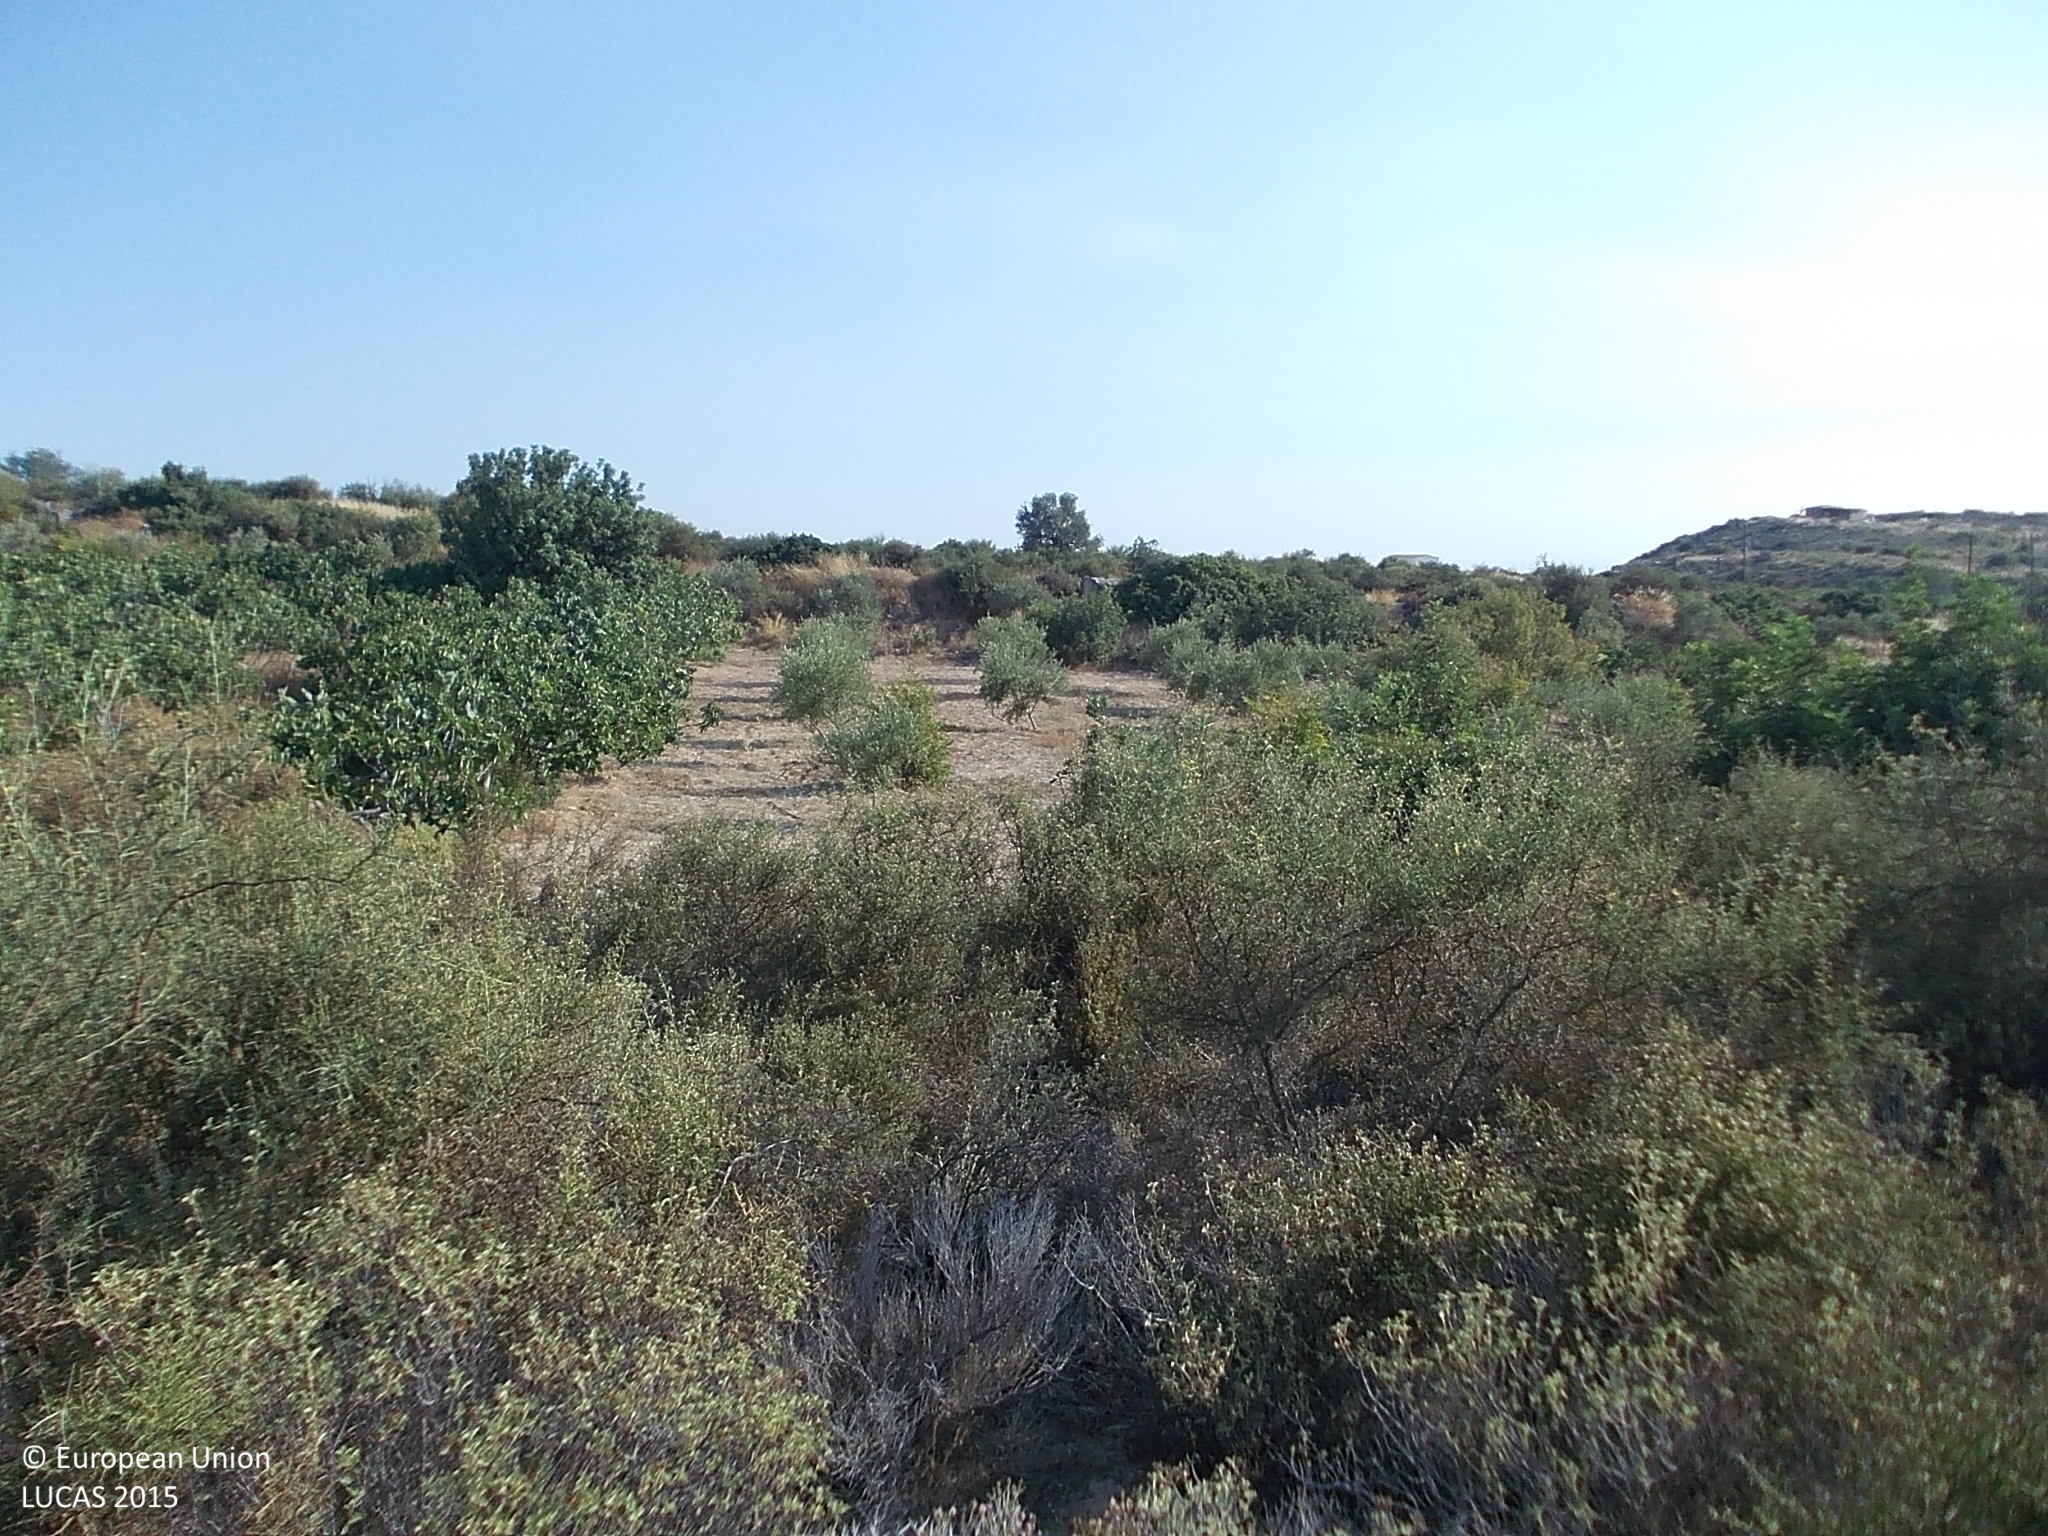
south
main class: Shrubland
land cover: Shrubland without tree cover
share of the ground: > 75 %
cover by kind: shrubs 90 %, unconsolidated bare surface 10 %
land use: Semi-natural and natural areas not in use
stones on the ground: 10 - 25 %
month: August
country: CY
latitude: 34.7543
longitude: 33.0084
